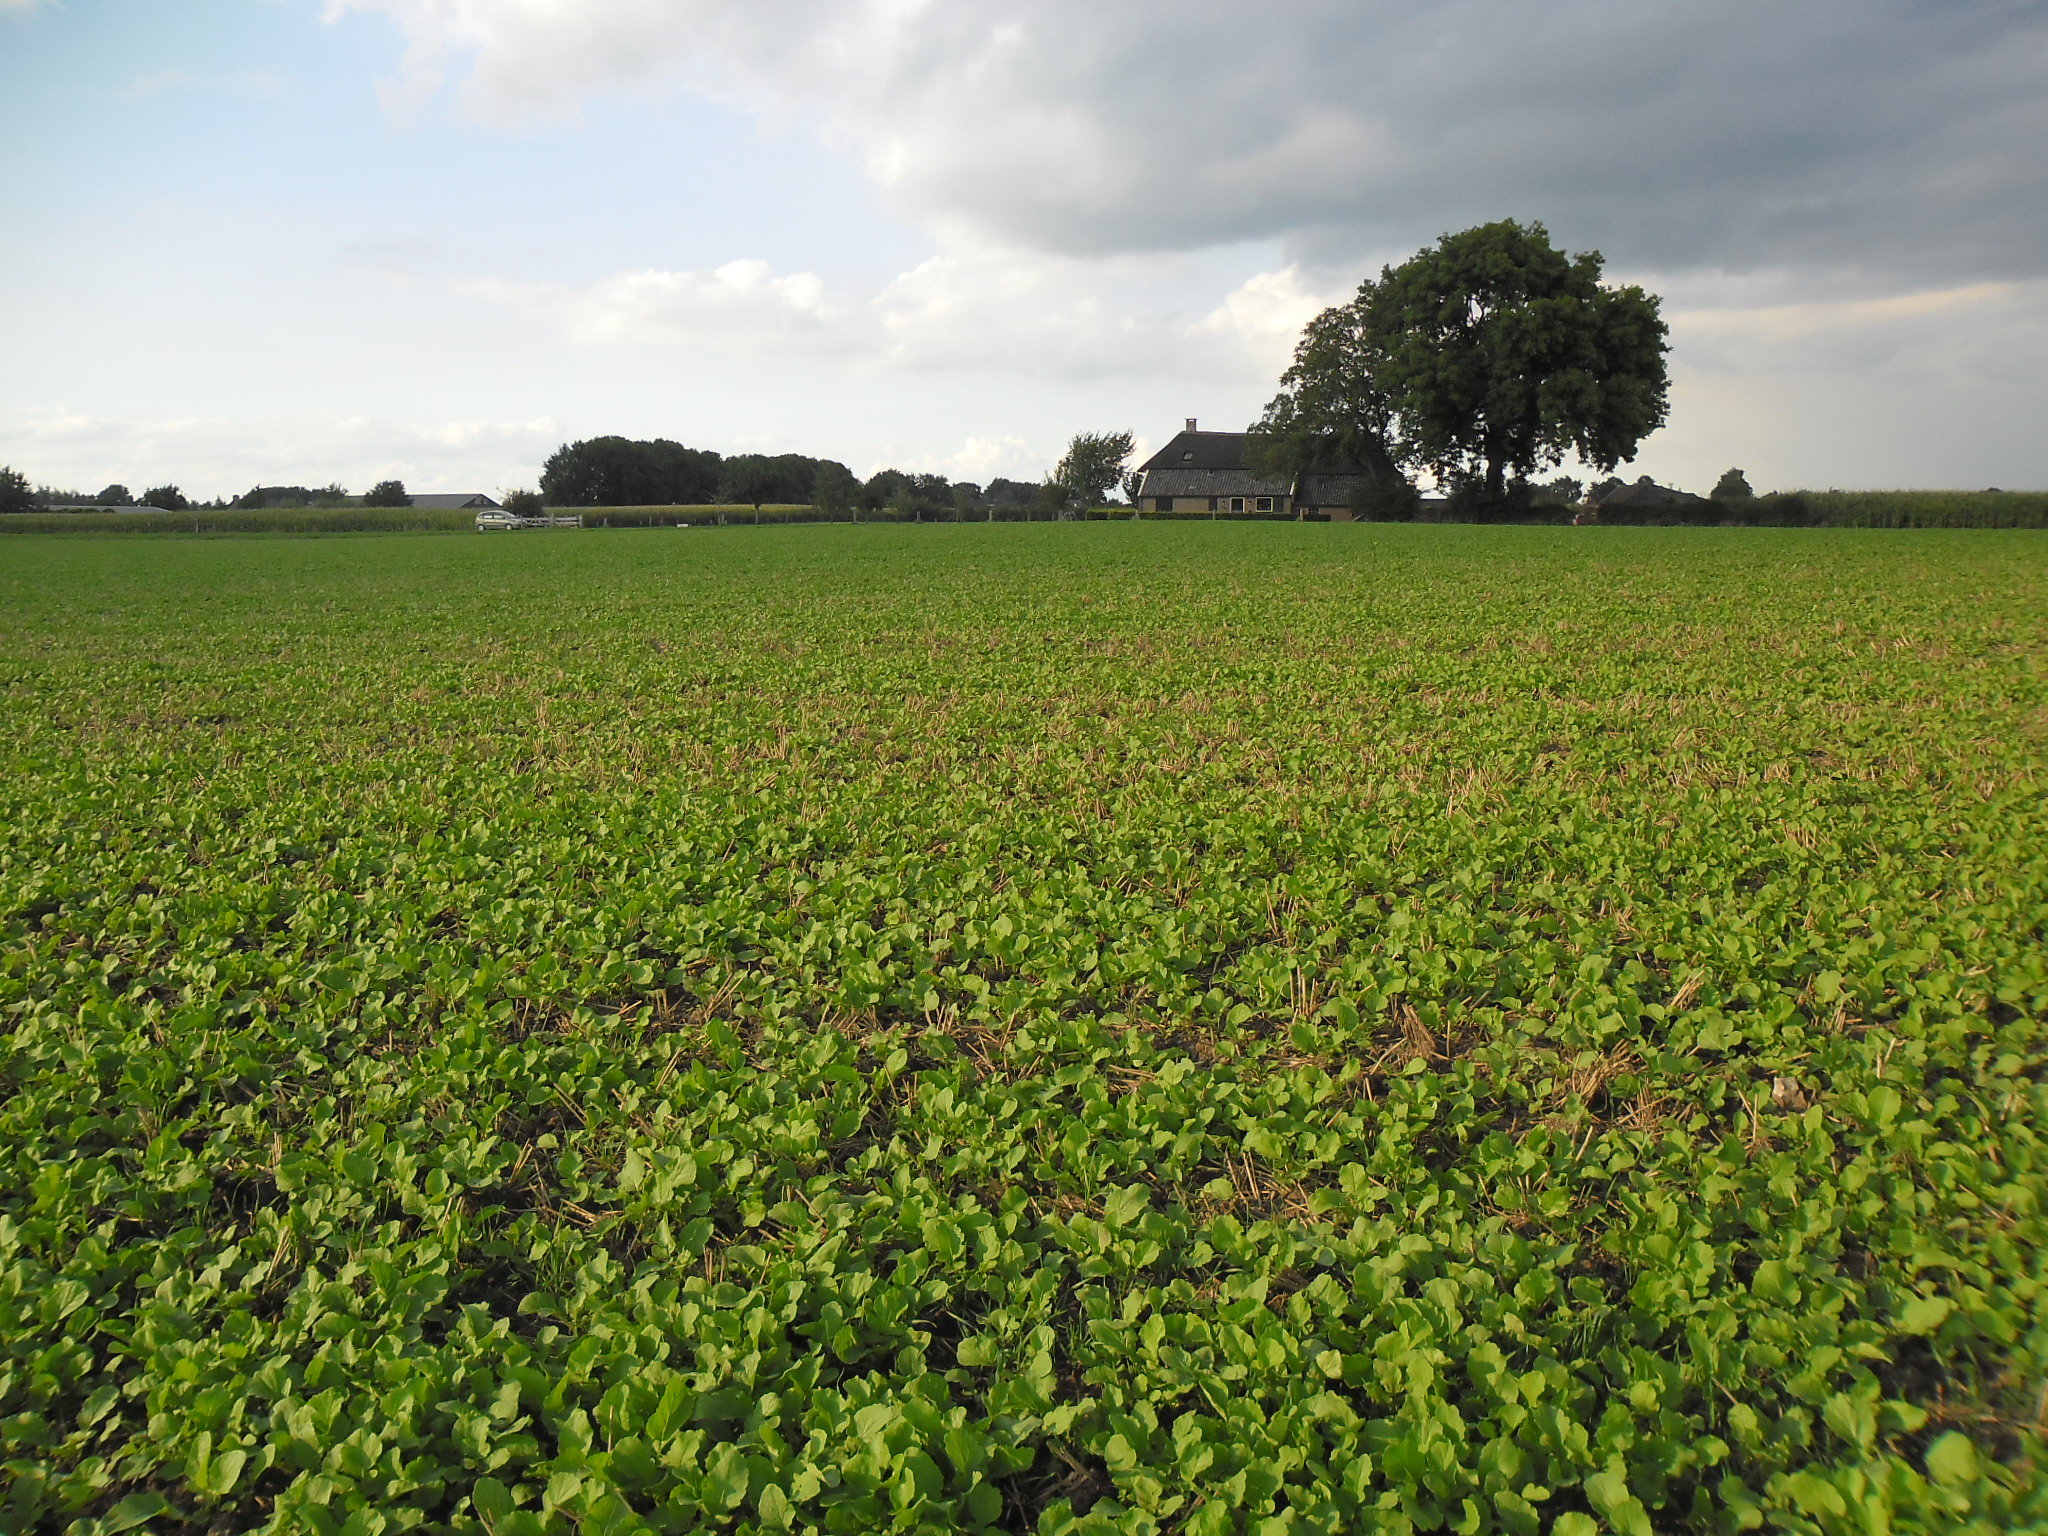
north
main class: Cropland
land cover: Common wheat
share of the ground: < 10 %
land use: Agriculture (excluding fallow land and kitchen gardens)
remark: Harvested field
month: September
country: NL
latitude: 52.0475
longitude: 6.2228
